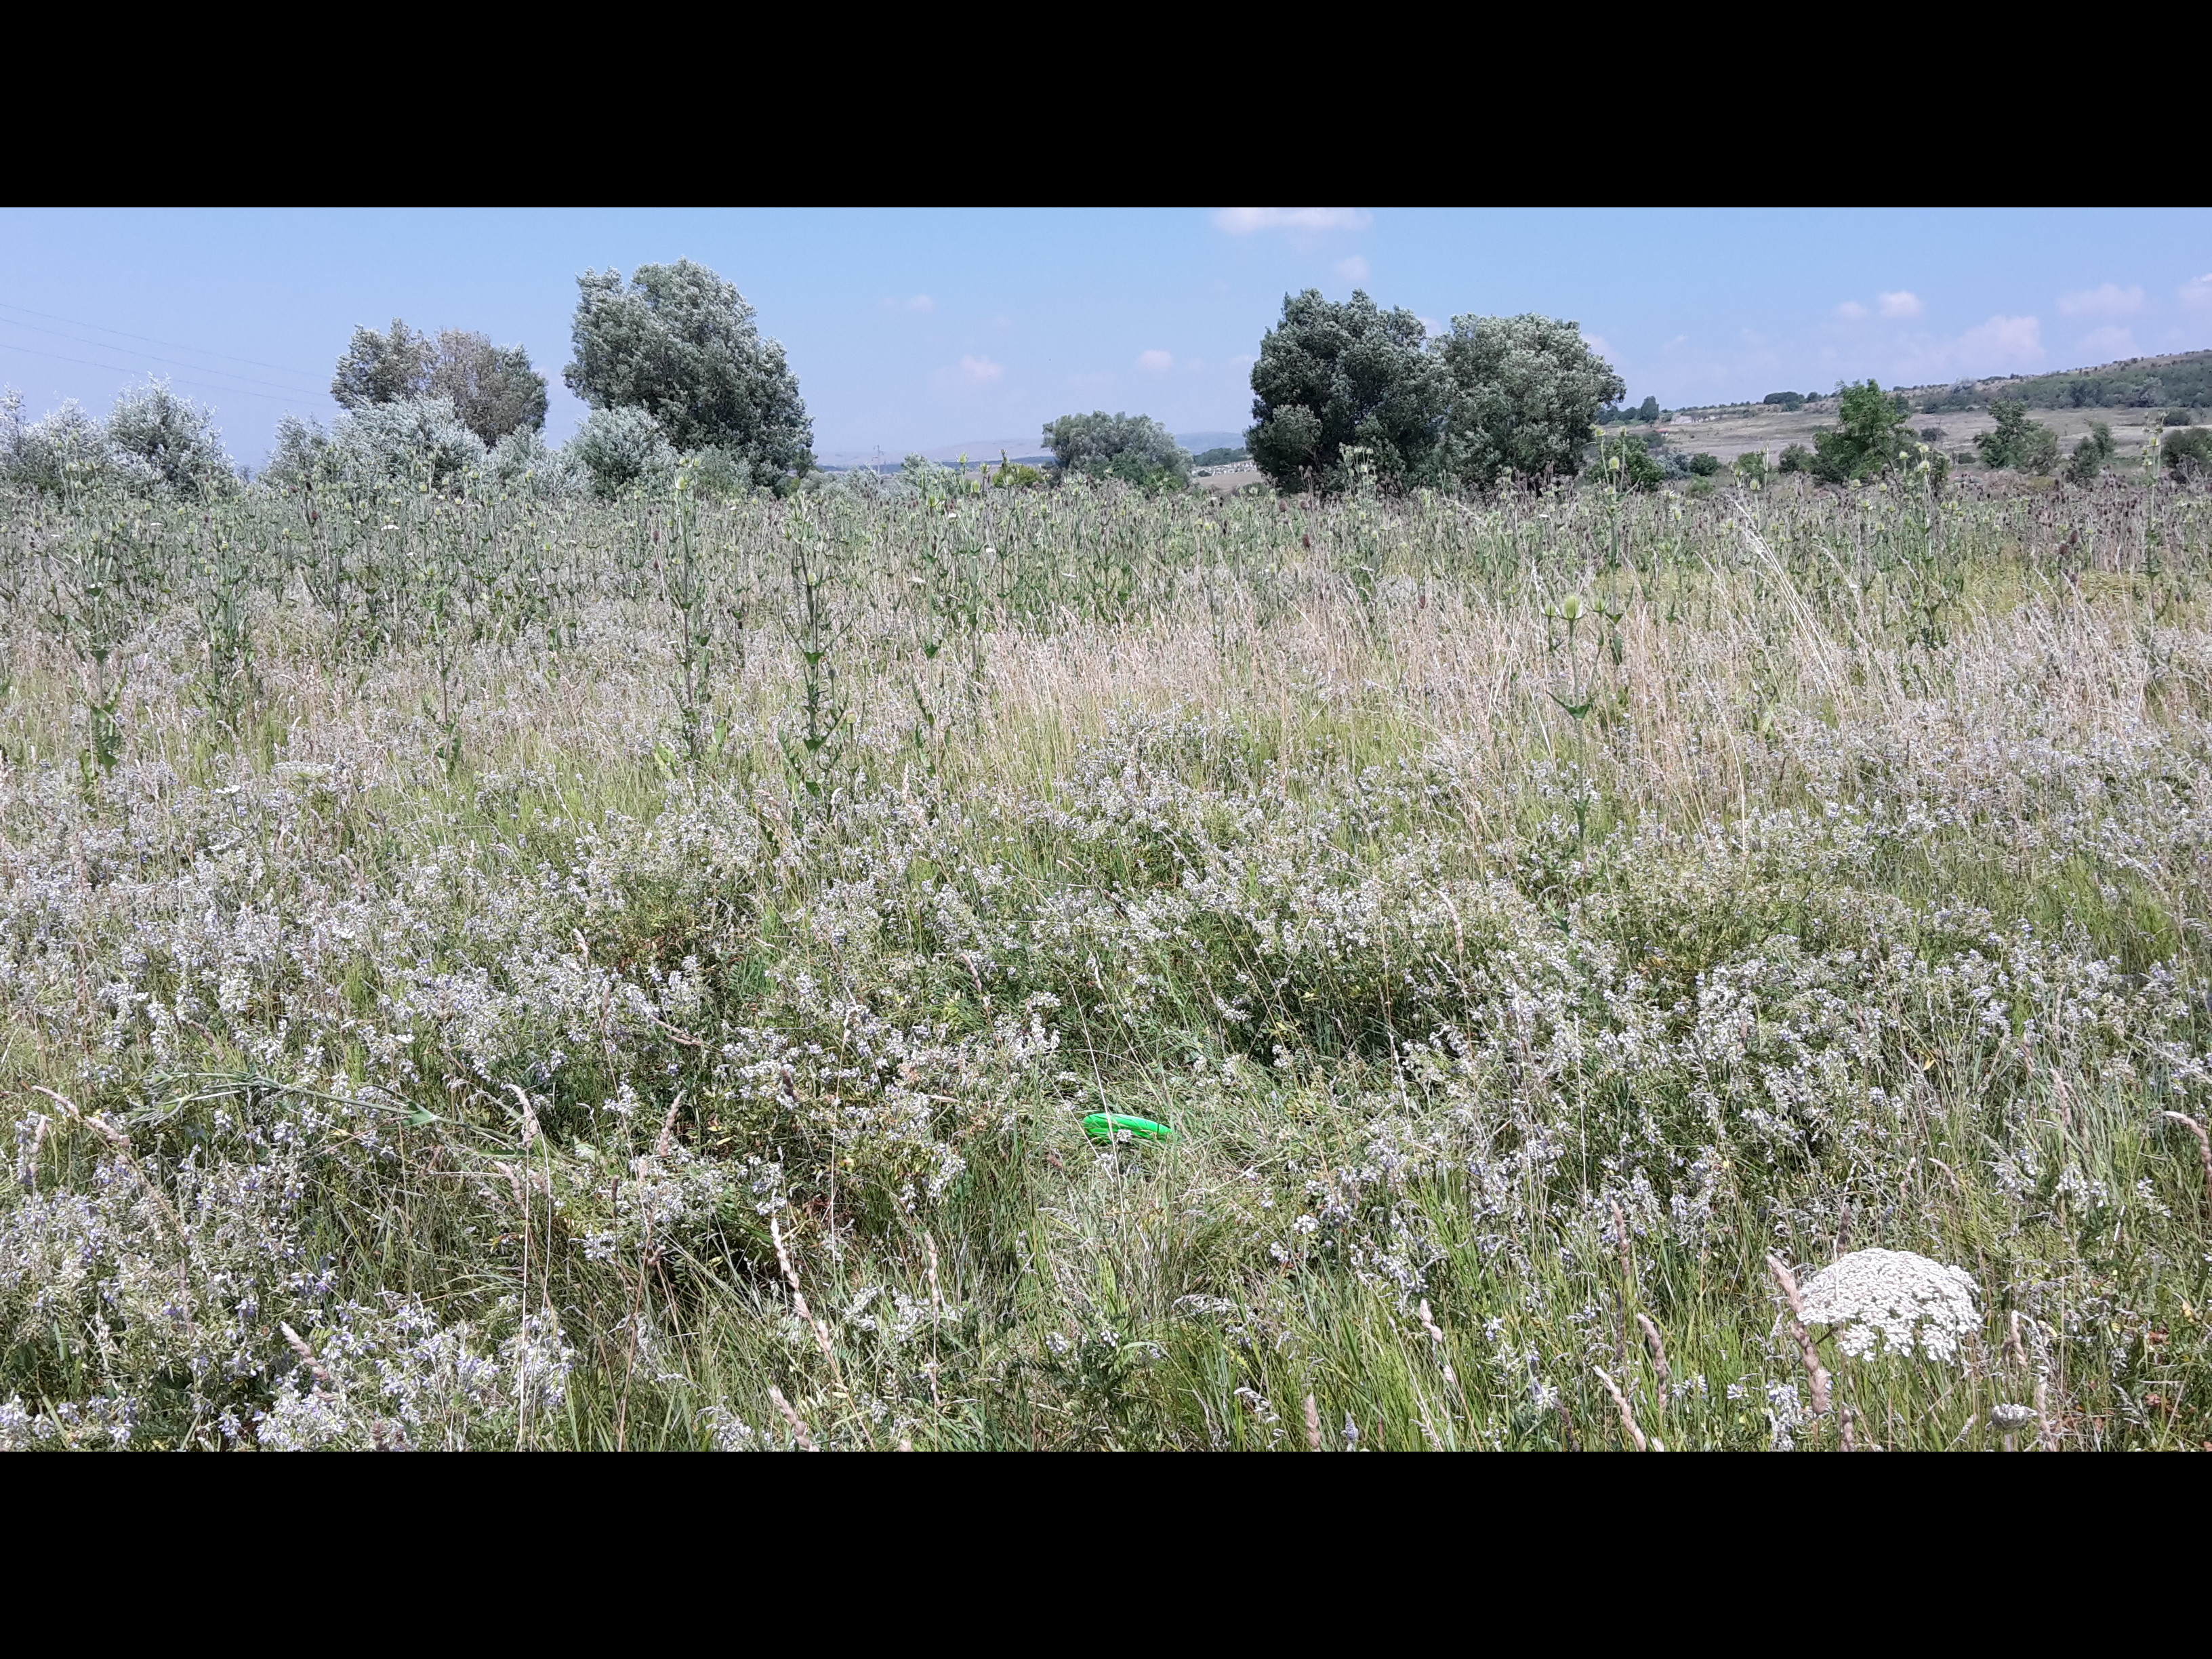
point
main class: Grassland
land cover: Grassland without tree/shrub cover
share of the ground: > 75 %
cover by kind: herbaceous plants 100 %
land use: Semi-natural and natural areas not in use
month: July
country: BG
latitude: 42.8263
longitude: 23.2081
